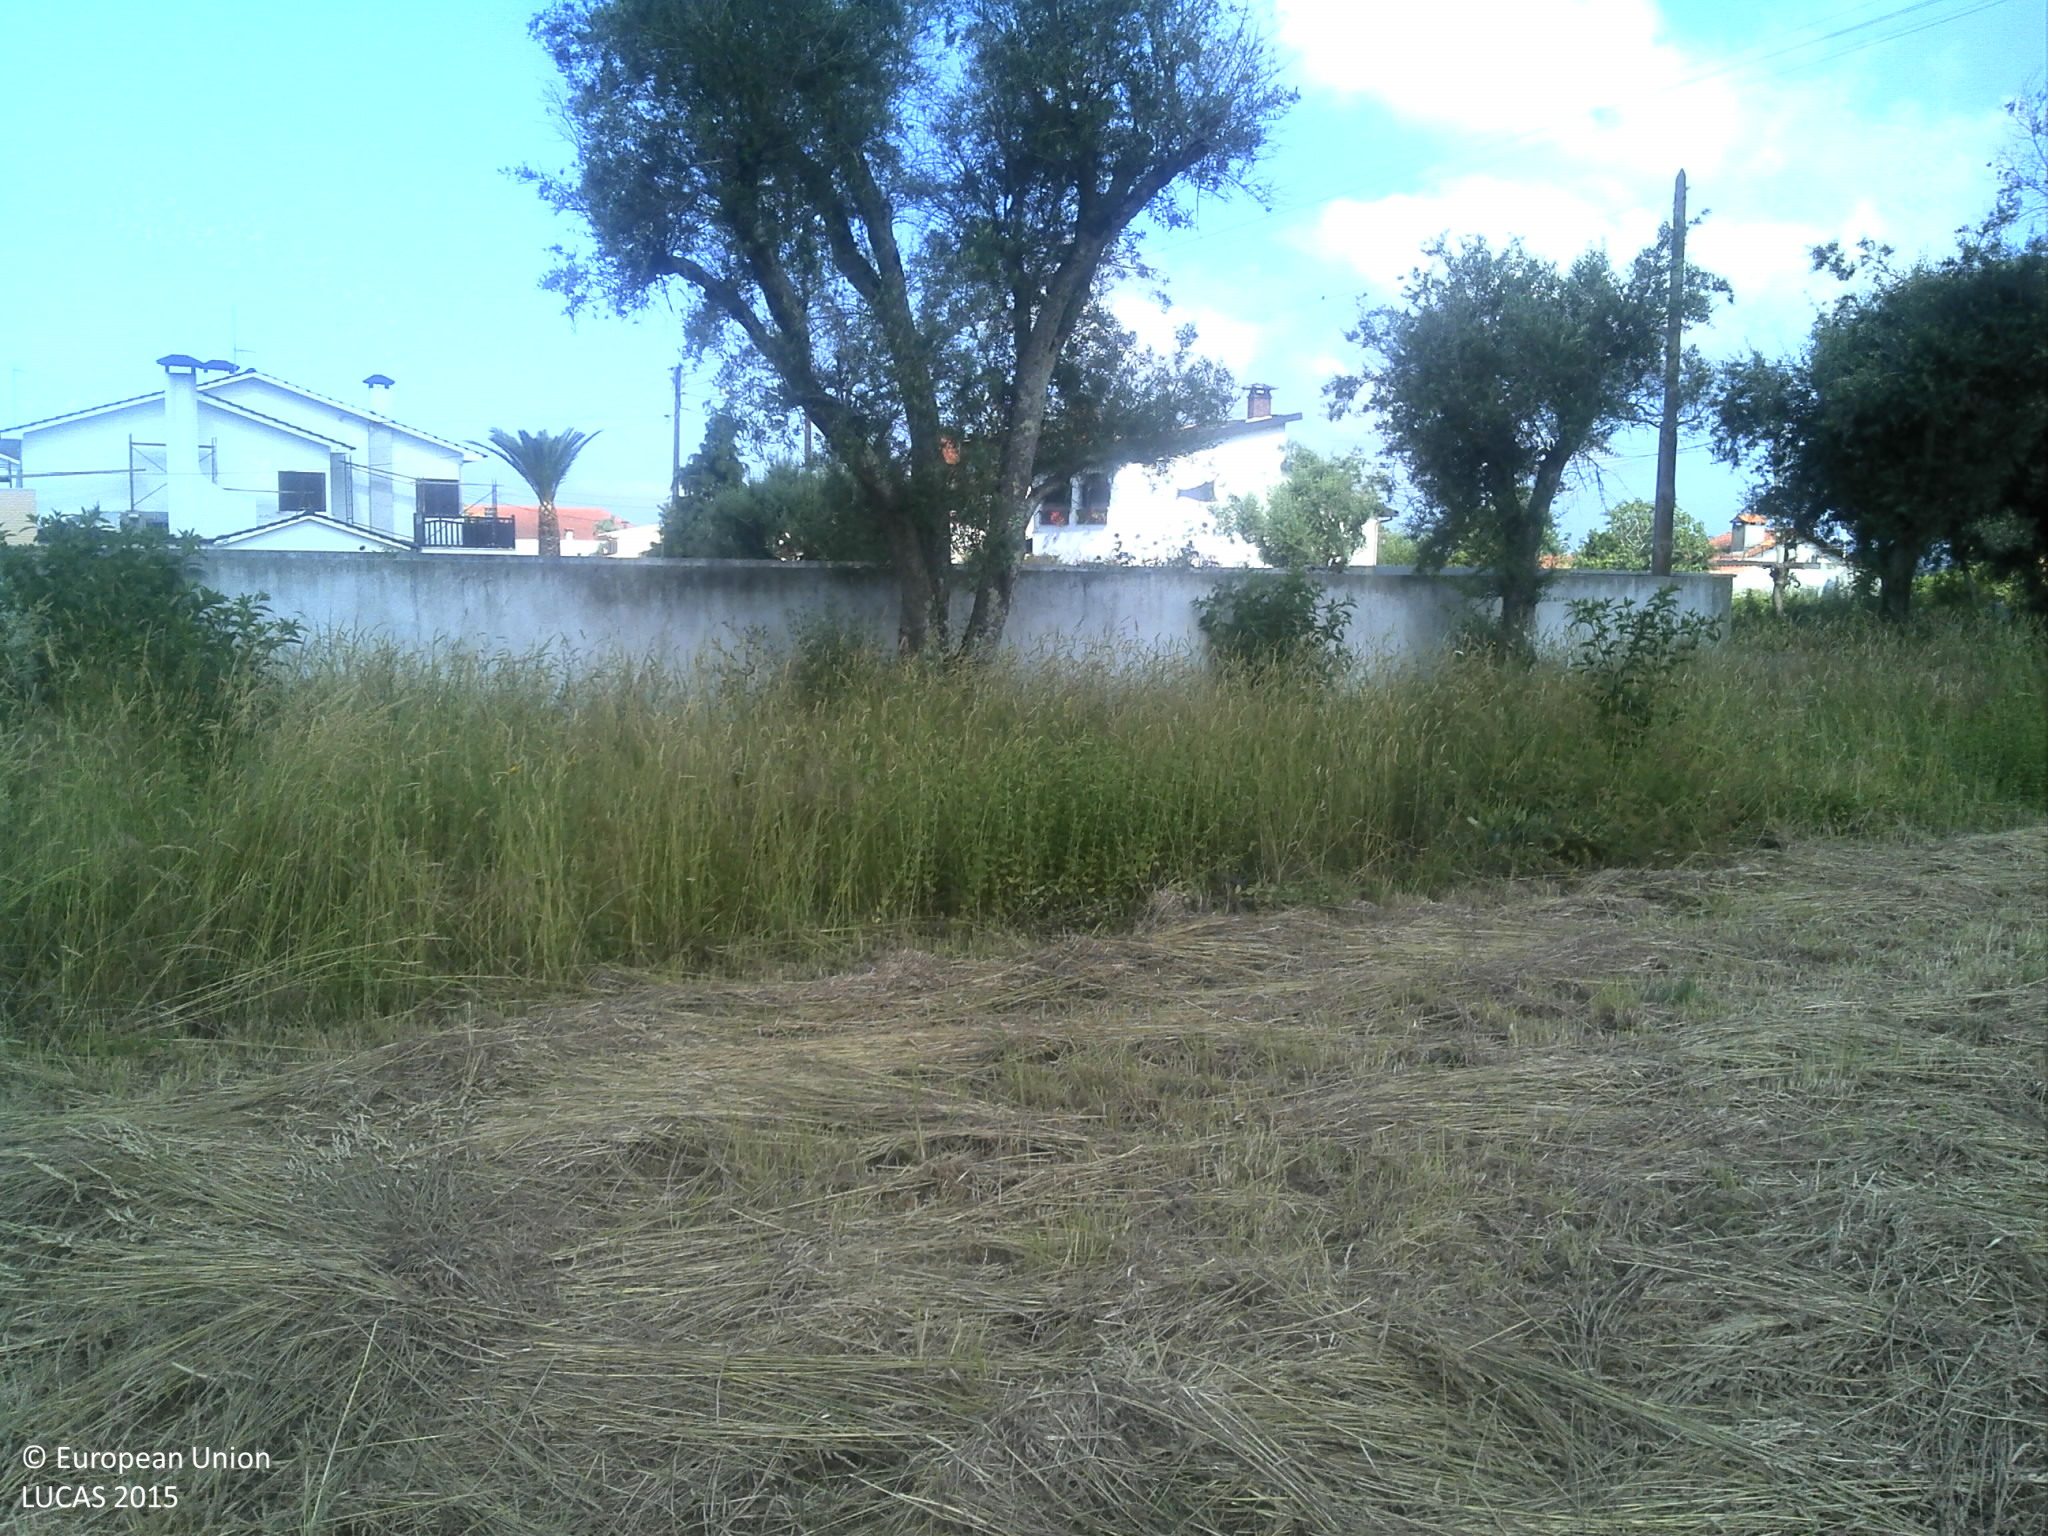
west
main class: Cropland
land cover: Temporary grasslands
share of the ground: 50 - 75 %
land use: Agriculture (excluding fallow land and kitchen gardens)
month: June
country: PT
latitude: 41.6142
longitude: -8.7042
